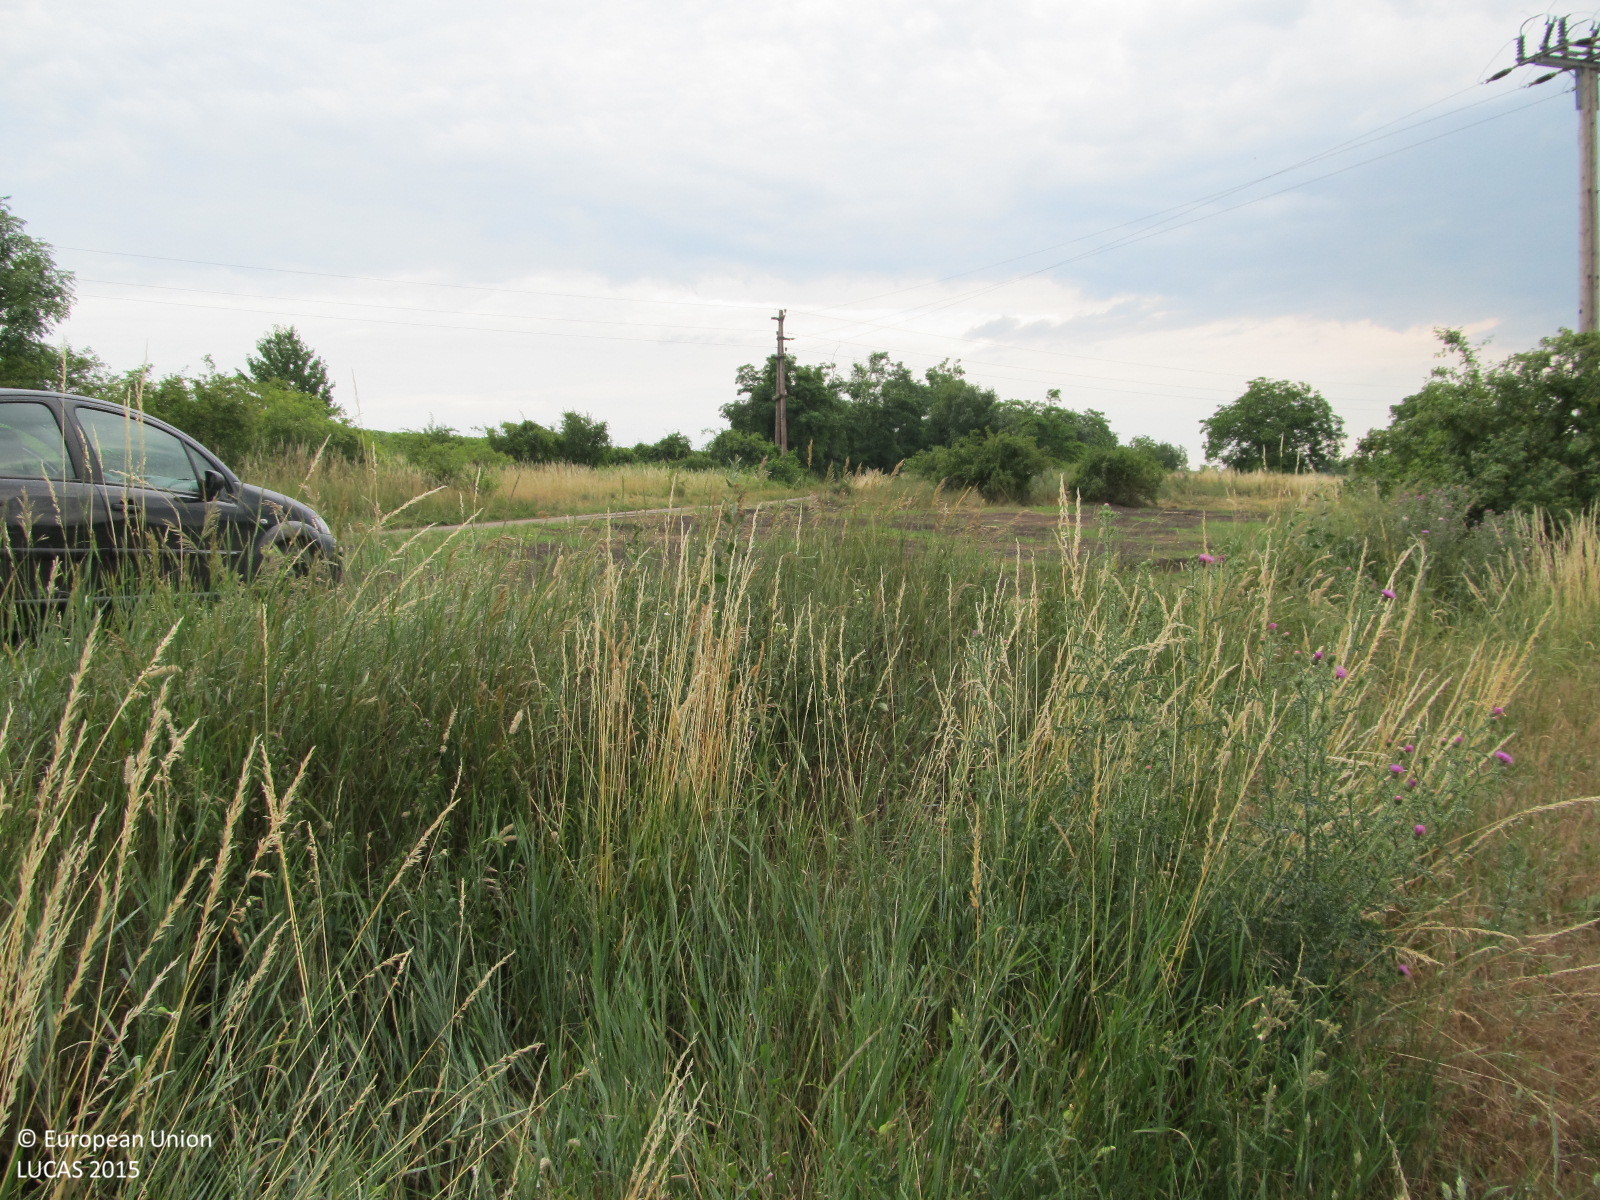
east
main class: Cropland
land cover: Durum wheat
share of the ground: > 75 %
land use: Agriculture (excluding fallow land and kitchen gardens)
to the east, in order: Durum wheat; Electric lines; Durum wheat; Grassland without tree/shrub cover; Tracks; Grassland without tree/shrub cover; Shrubland with sparse tree cover; Electric lines; Shrubland with sparse tree cover; Paved roads, cycling and walking lanes; Grass margins; Electric lines; Broadleaved woodland; Vineyards; Grassland without tree/shrub cover
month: June
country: AT
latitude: 48.7141
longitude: 15.9164
